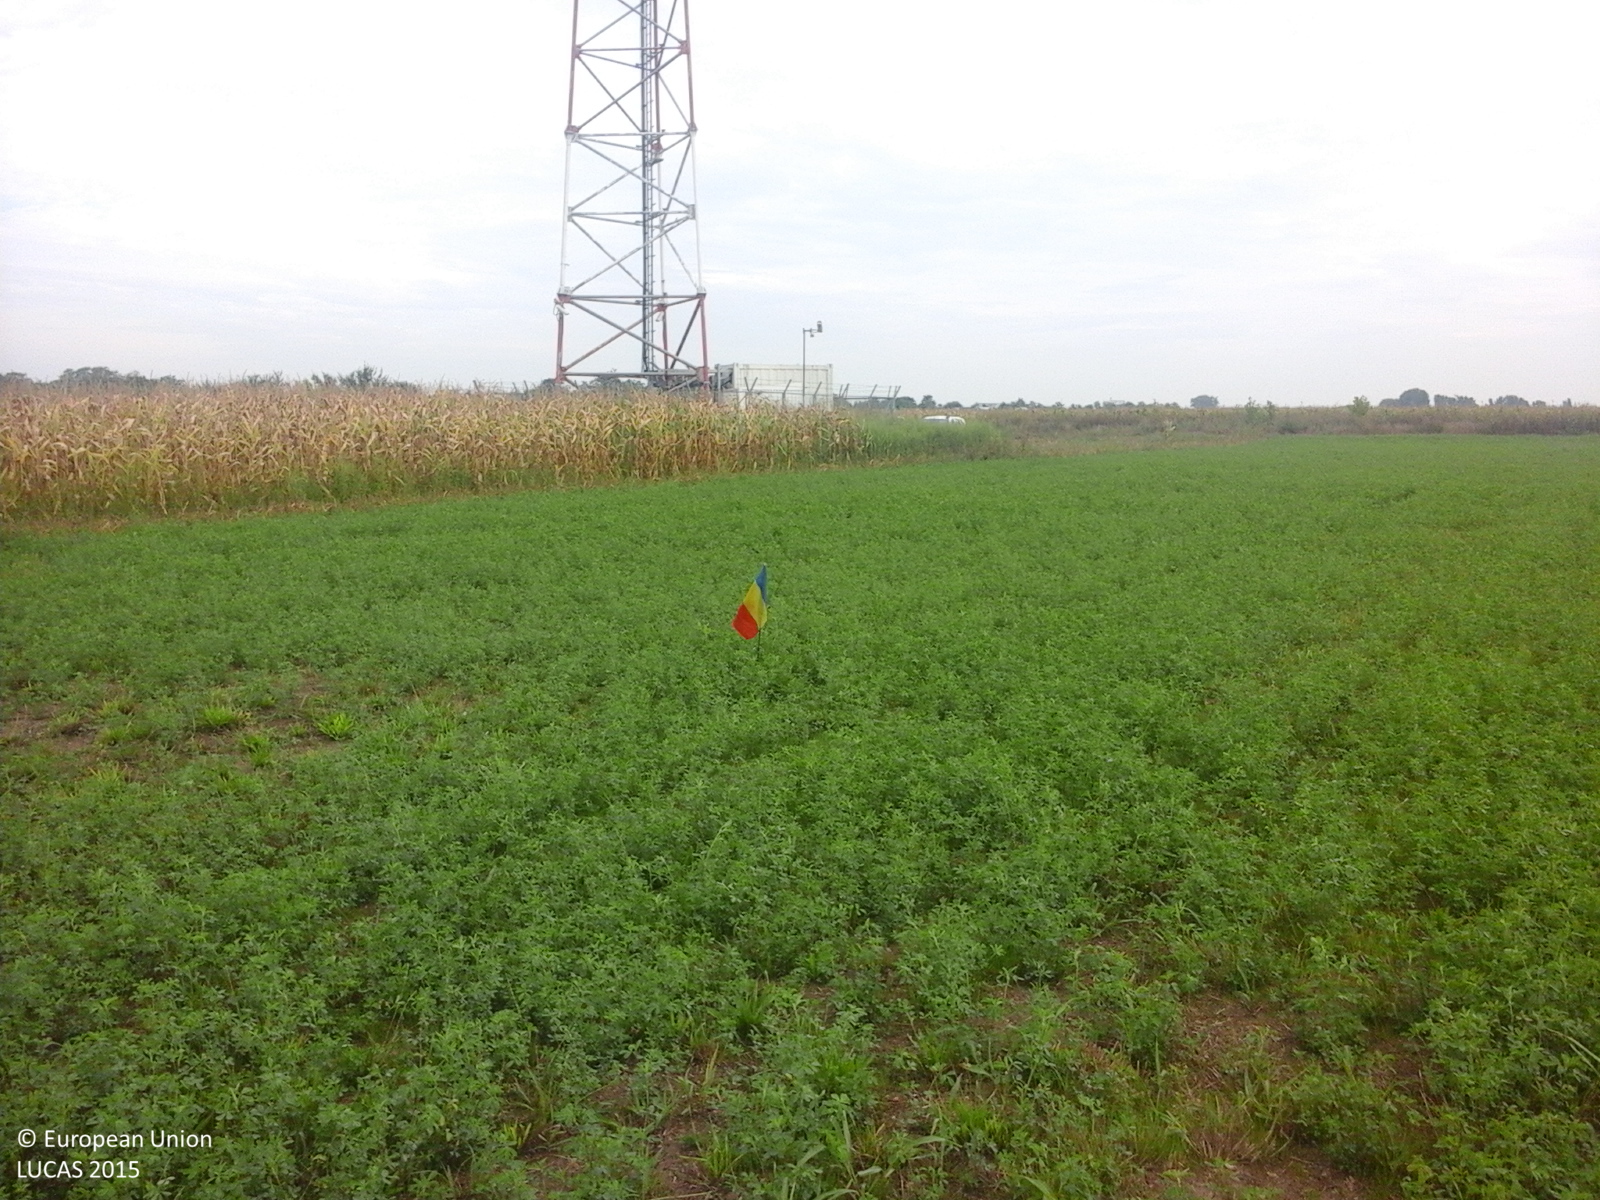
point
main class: Cropland
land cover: Lucerne
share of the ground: > 75 %
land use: Agriculture (excluding fallow land and kitchen gardens)
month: August
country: RO
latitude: 46.1057
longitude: 20.8567
